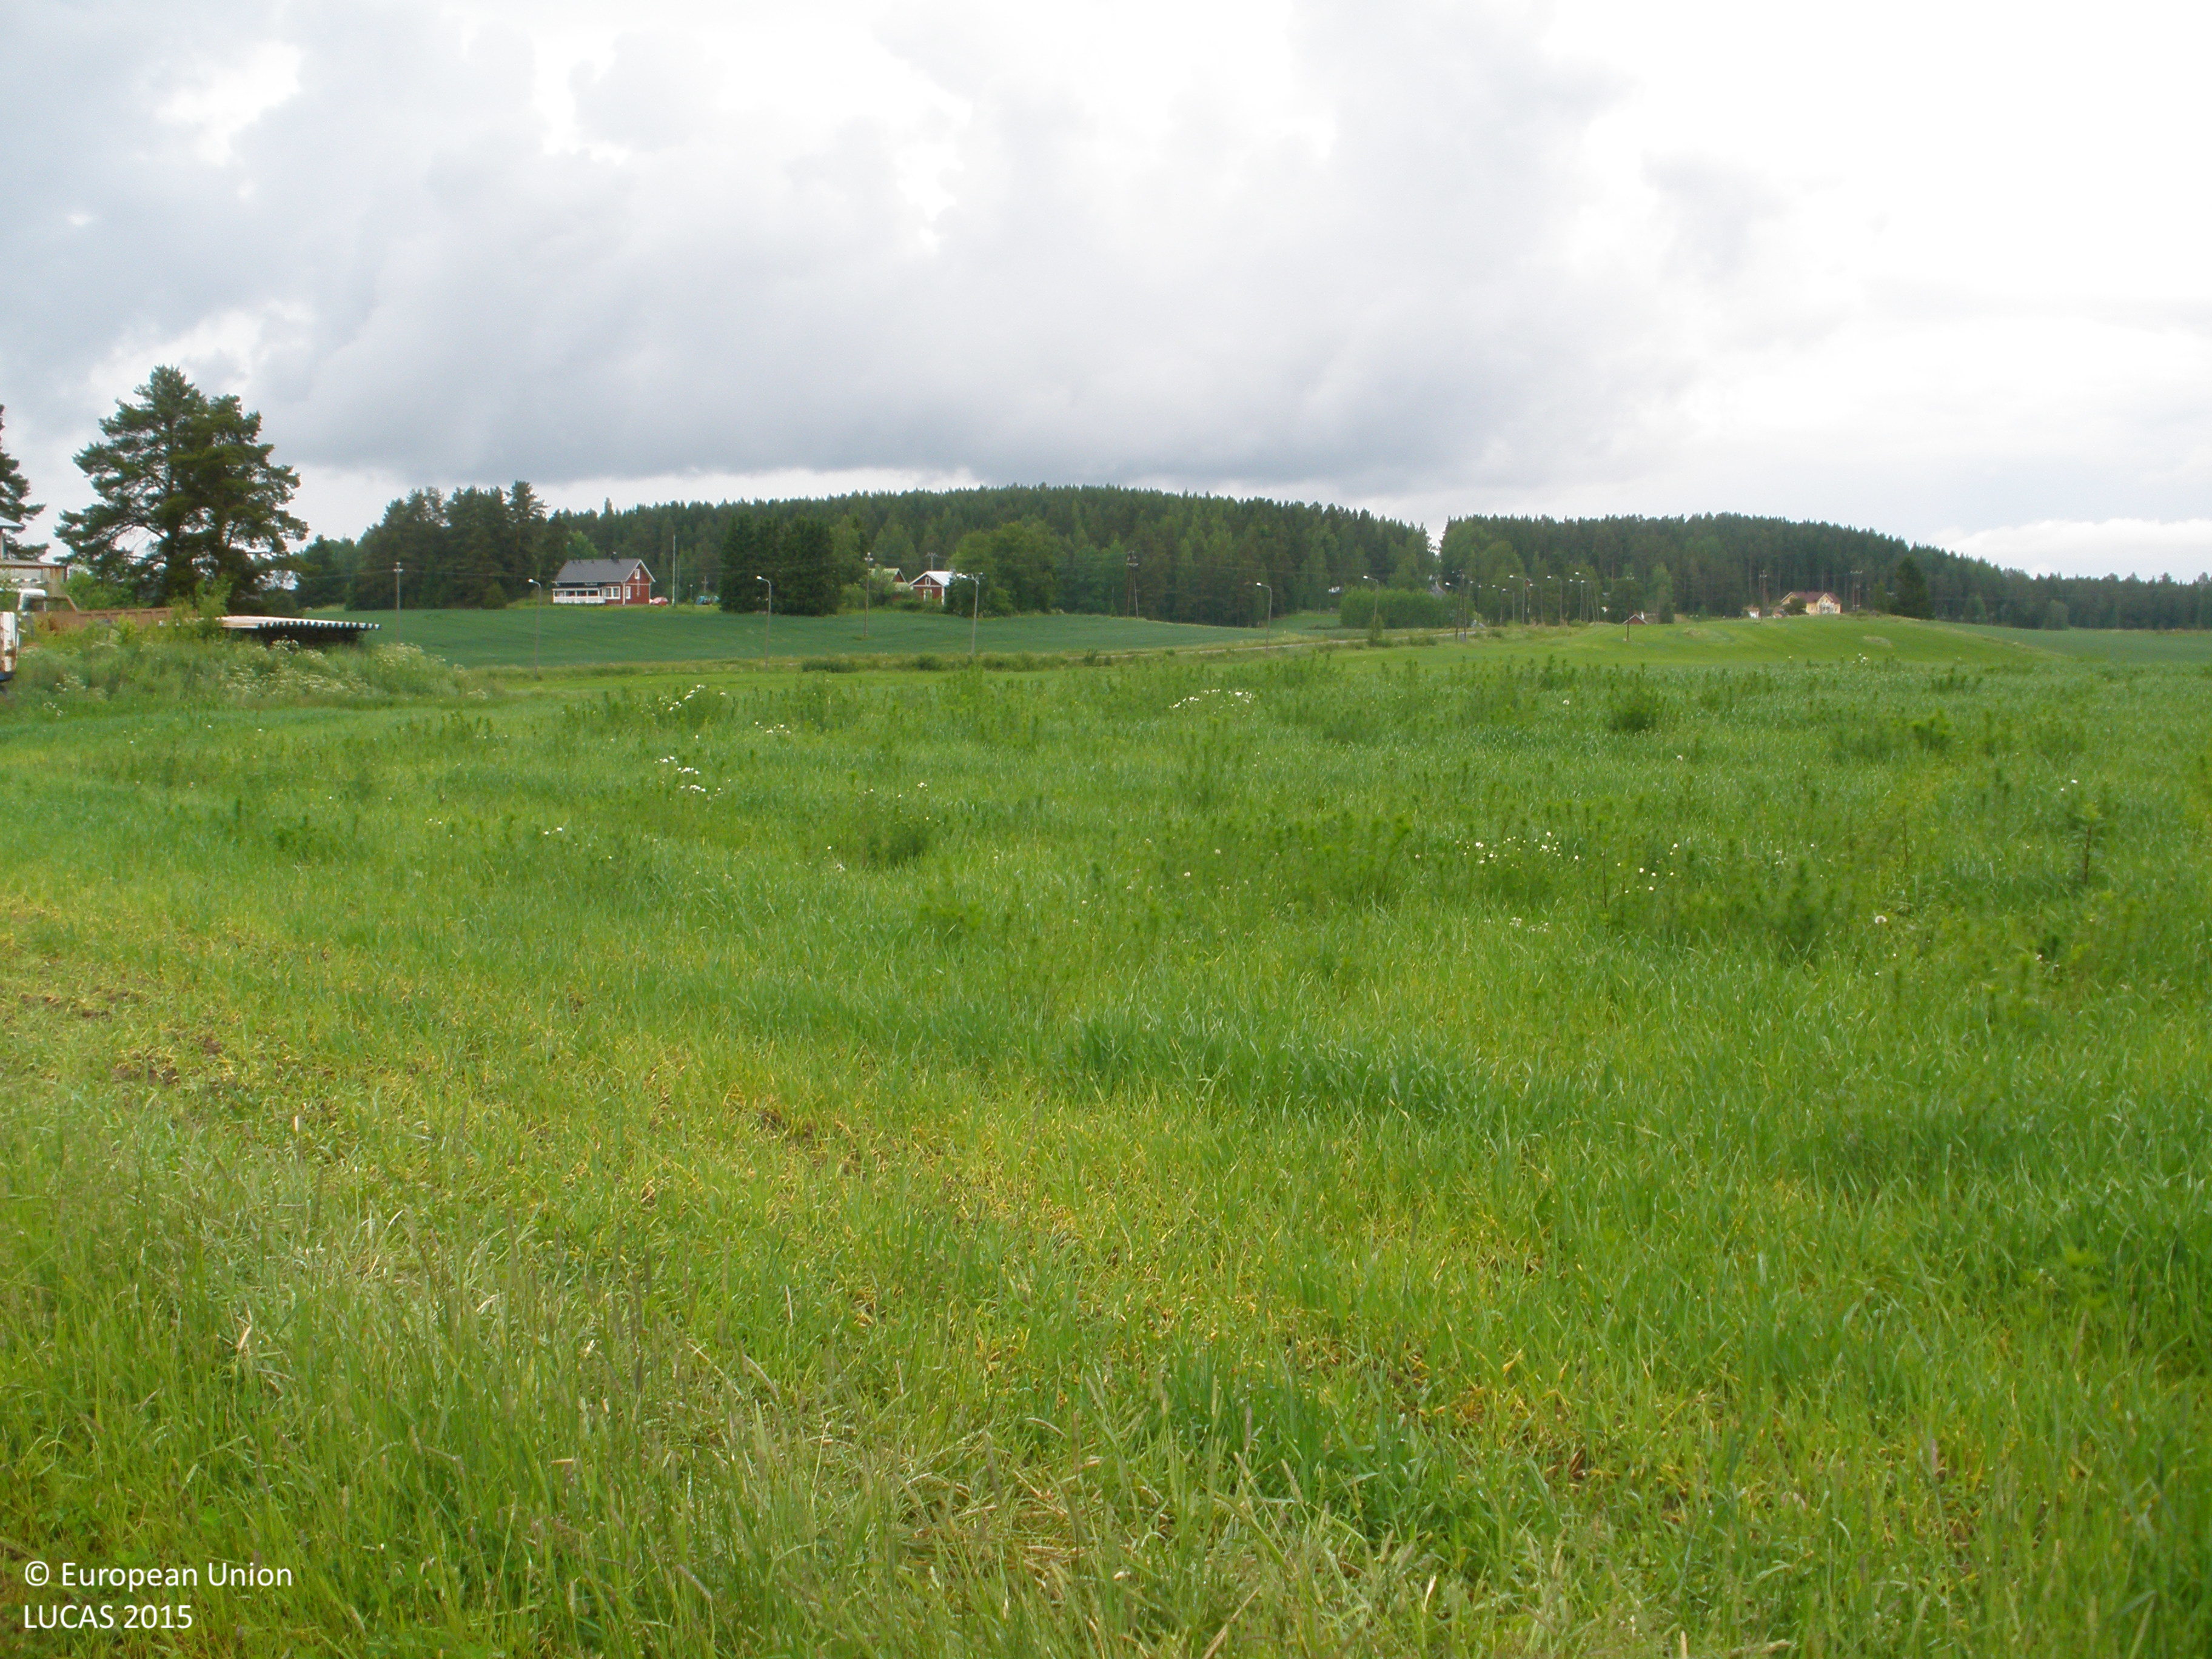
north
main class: Cropland
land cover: Barley
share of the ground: > 75 %
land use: Agriculture (excluding fallow land and kitchen gardens)
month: June
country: FI
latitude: 61.1422
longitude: 23.8518
